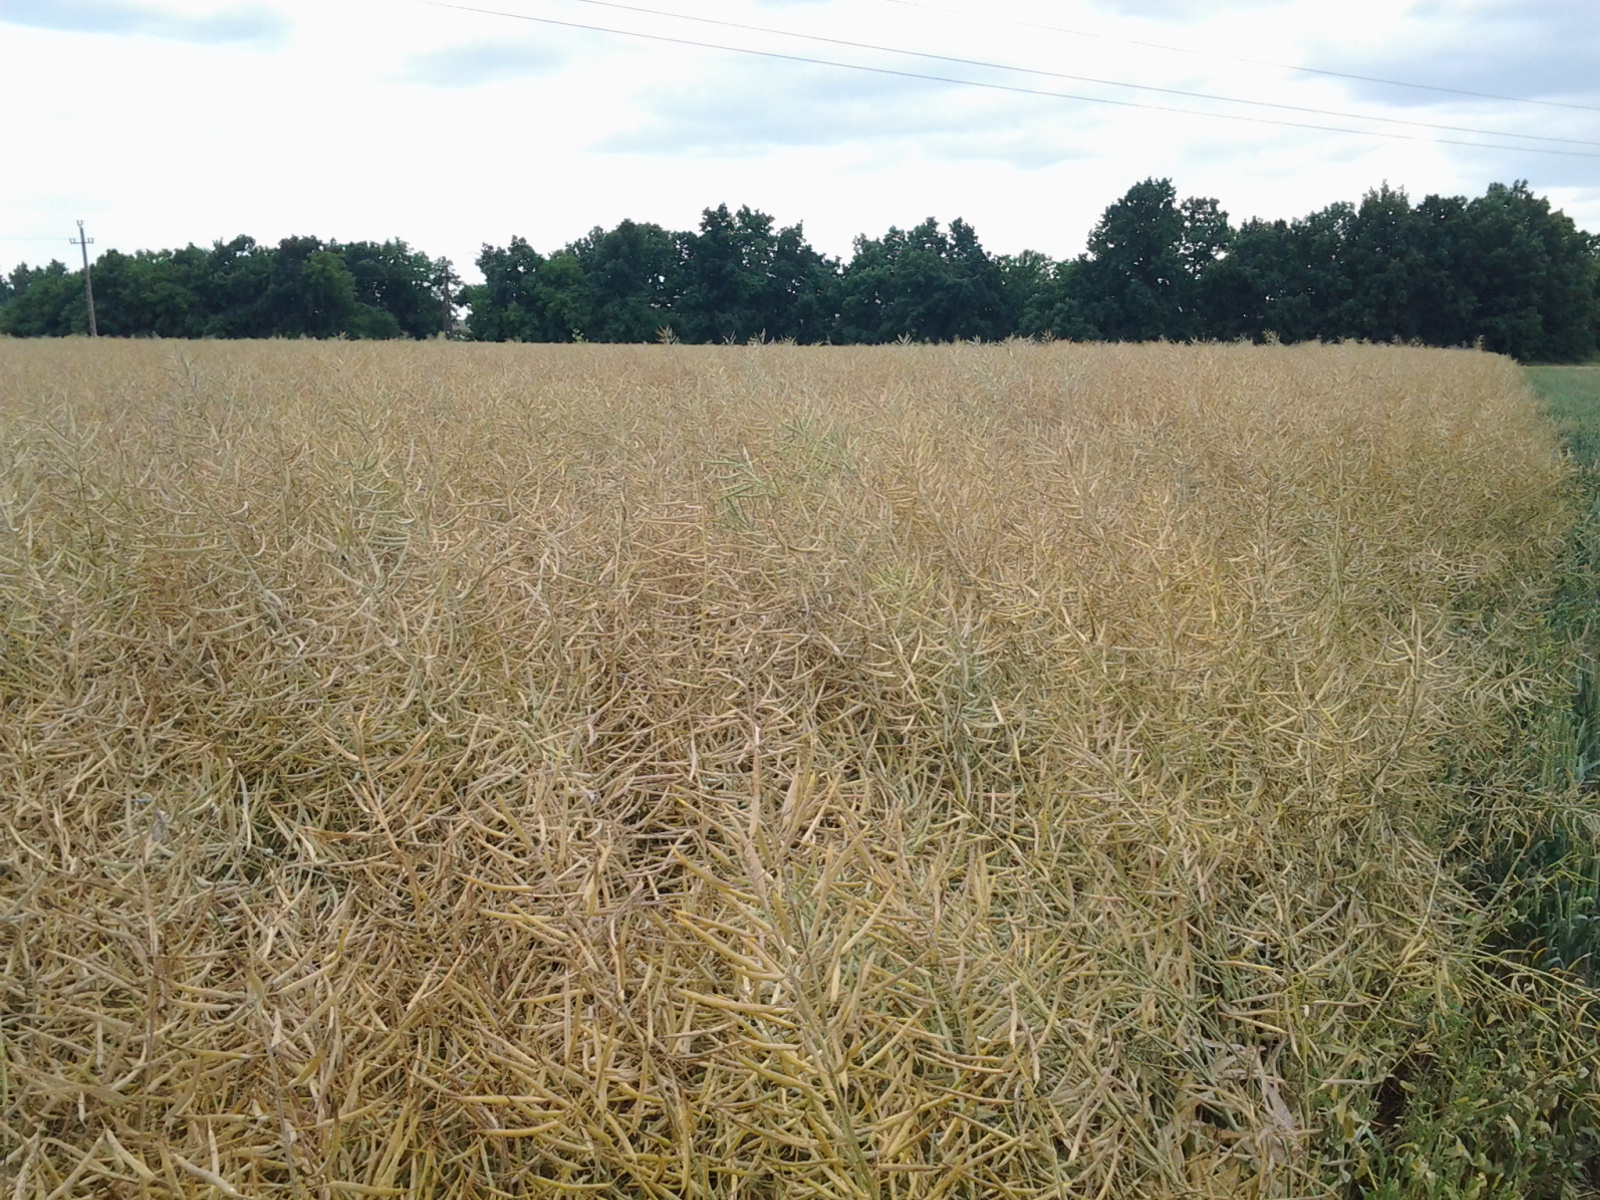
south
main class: Cropland
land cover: Rape and turnip rape
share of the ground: > 75 %
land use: Agriculture (excluding fallow land and kitchen gardens)
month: June
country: HU
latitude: 47.6258
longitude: 19.9664
